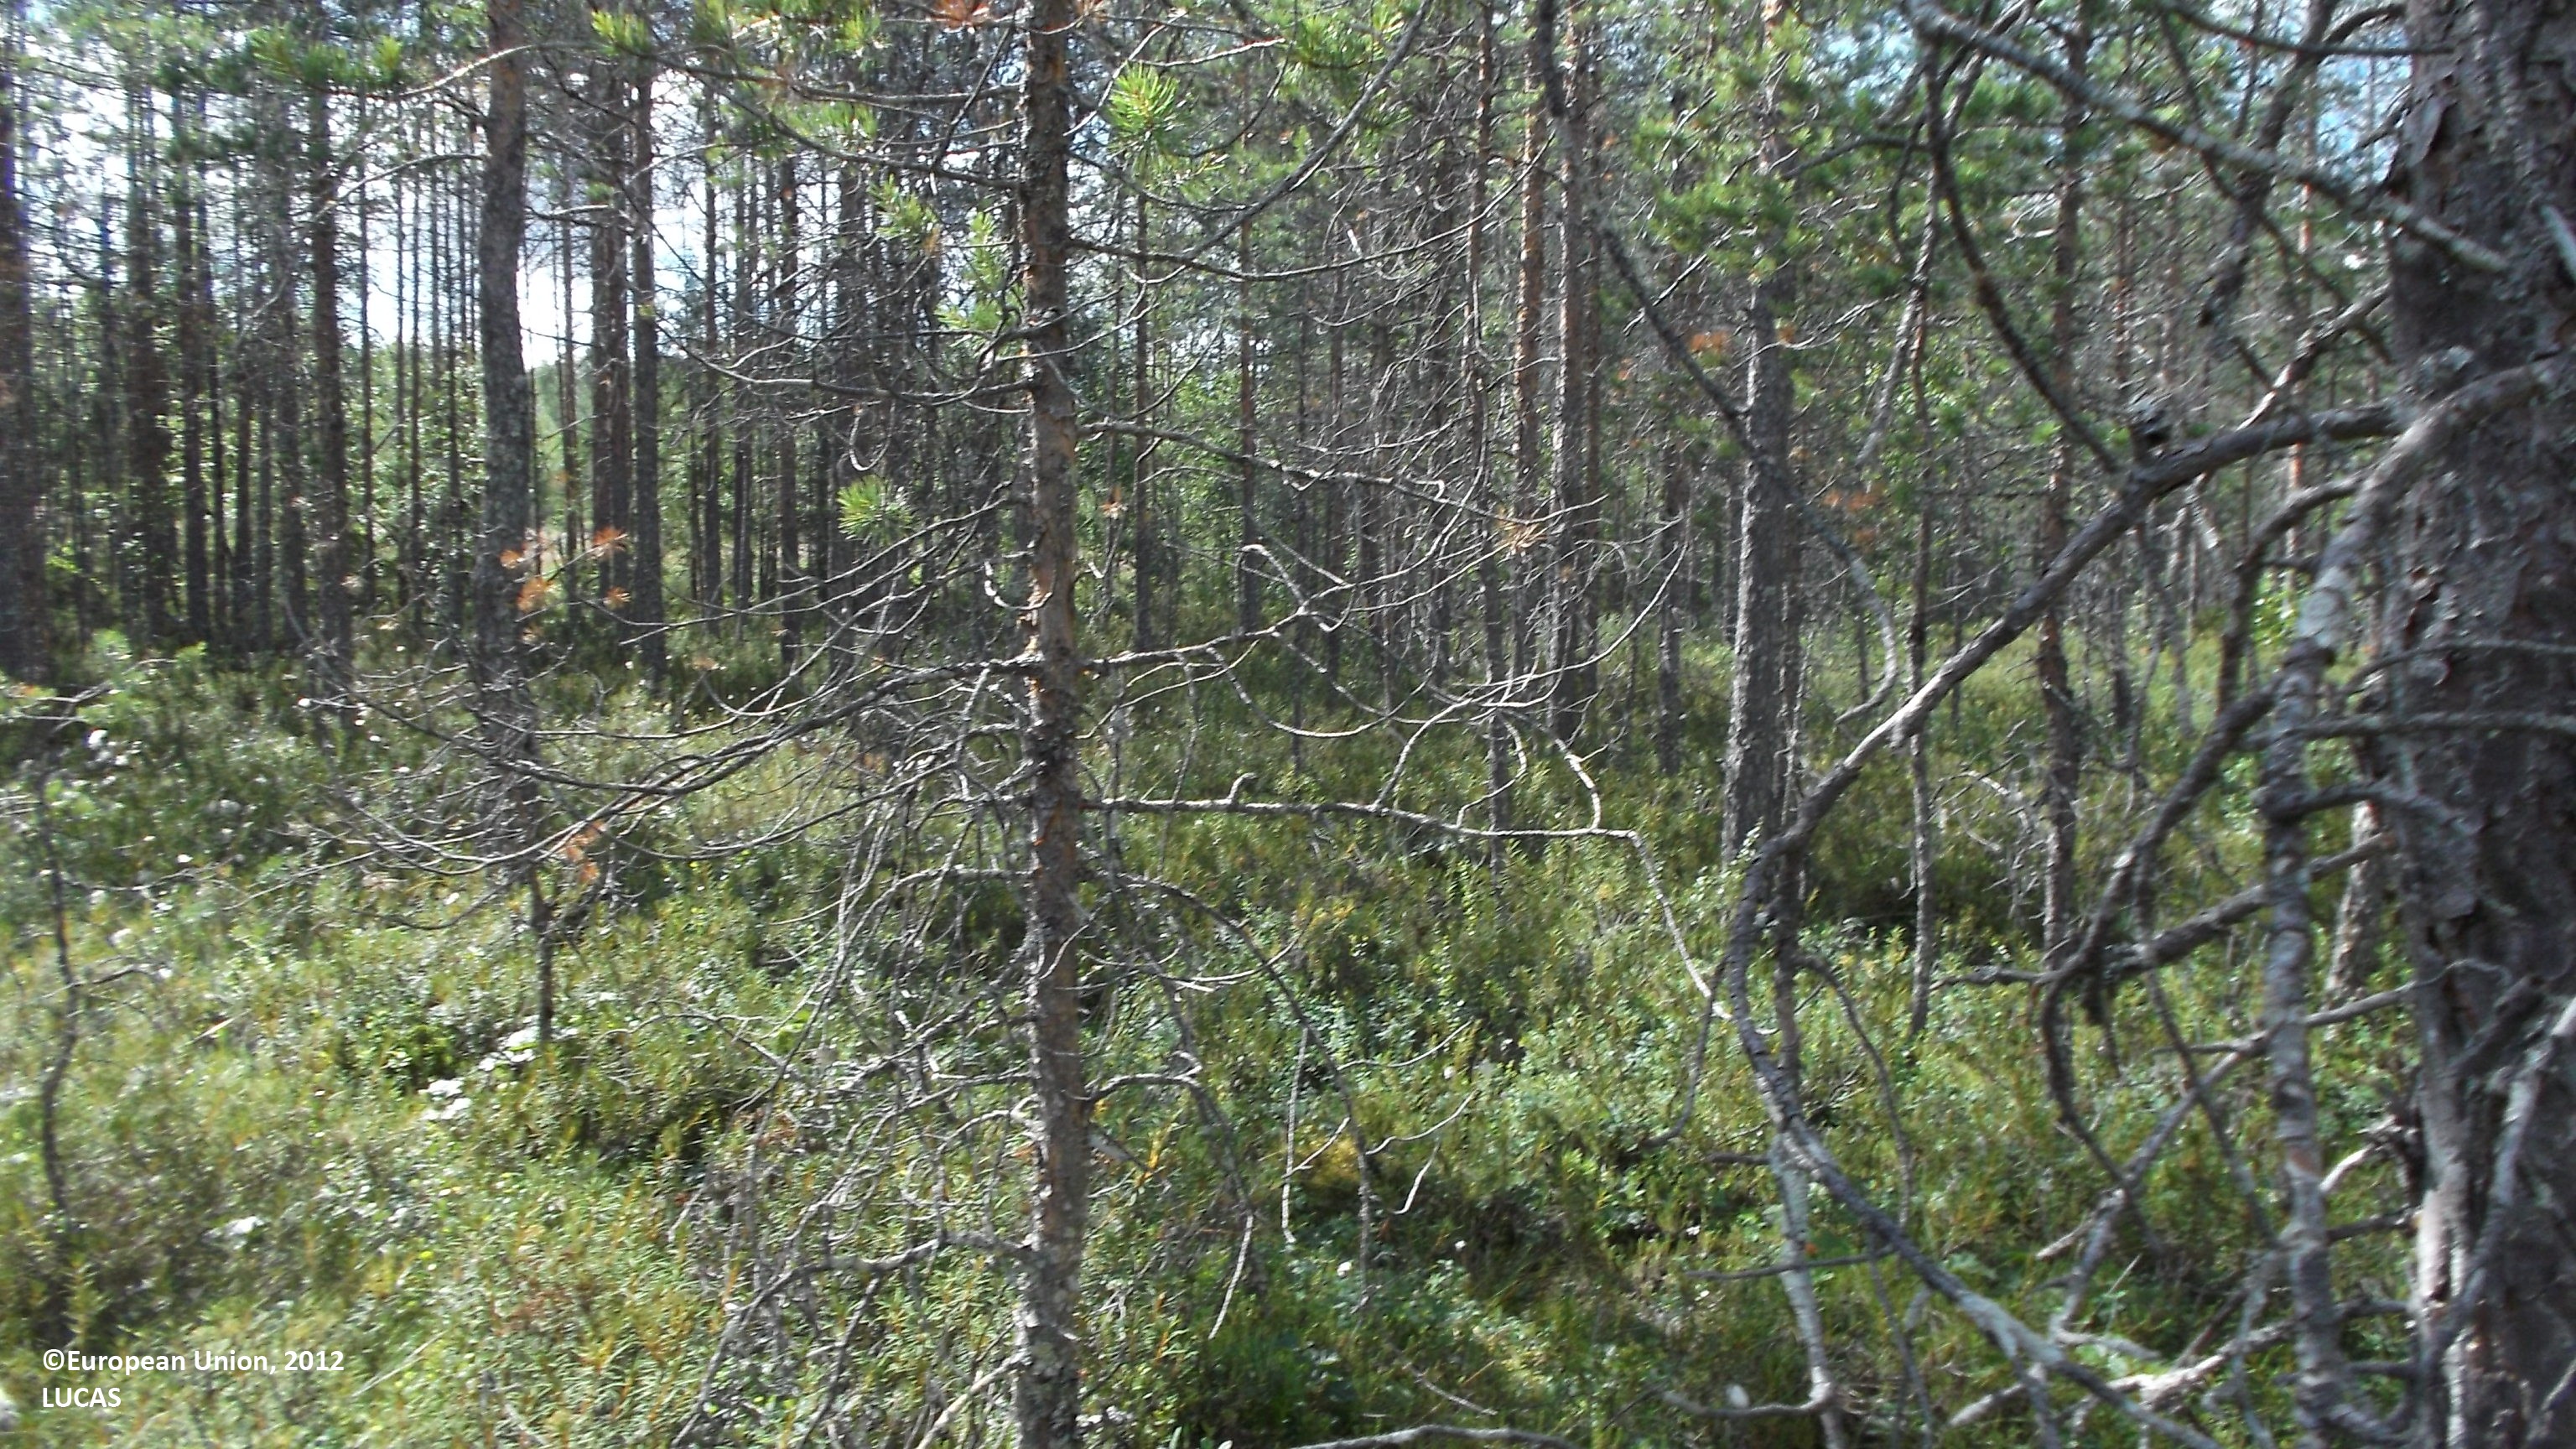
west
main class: Woodland
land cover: Pine dominated coniferous woodland
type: mire and swamp forests
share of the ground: 50 - 75 %
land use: Forestry
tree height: < 5 m
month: July
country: FI
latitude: 63.2730
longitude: 23.8415
